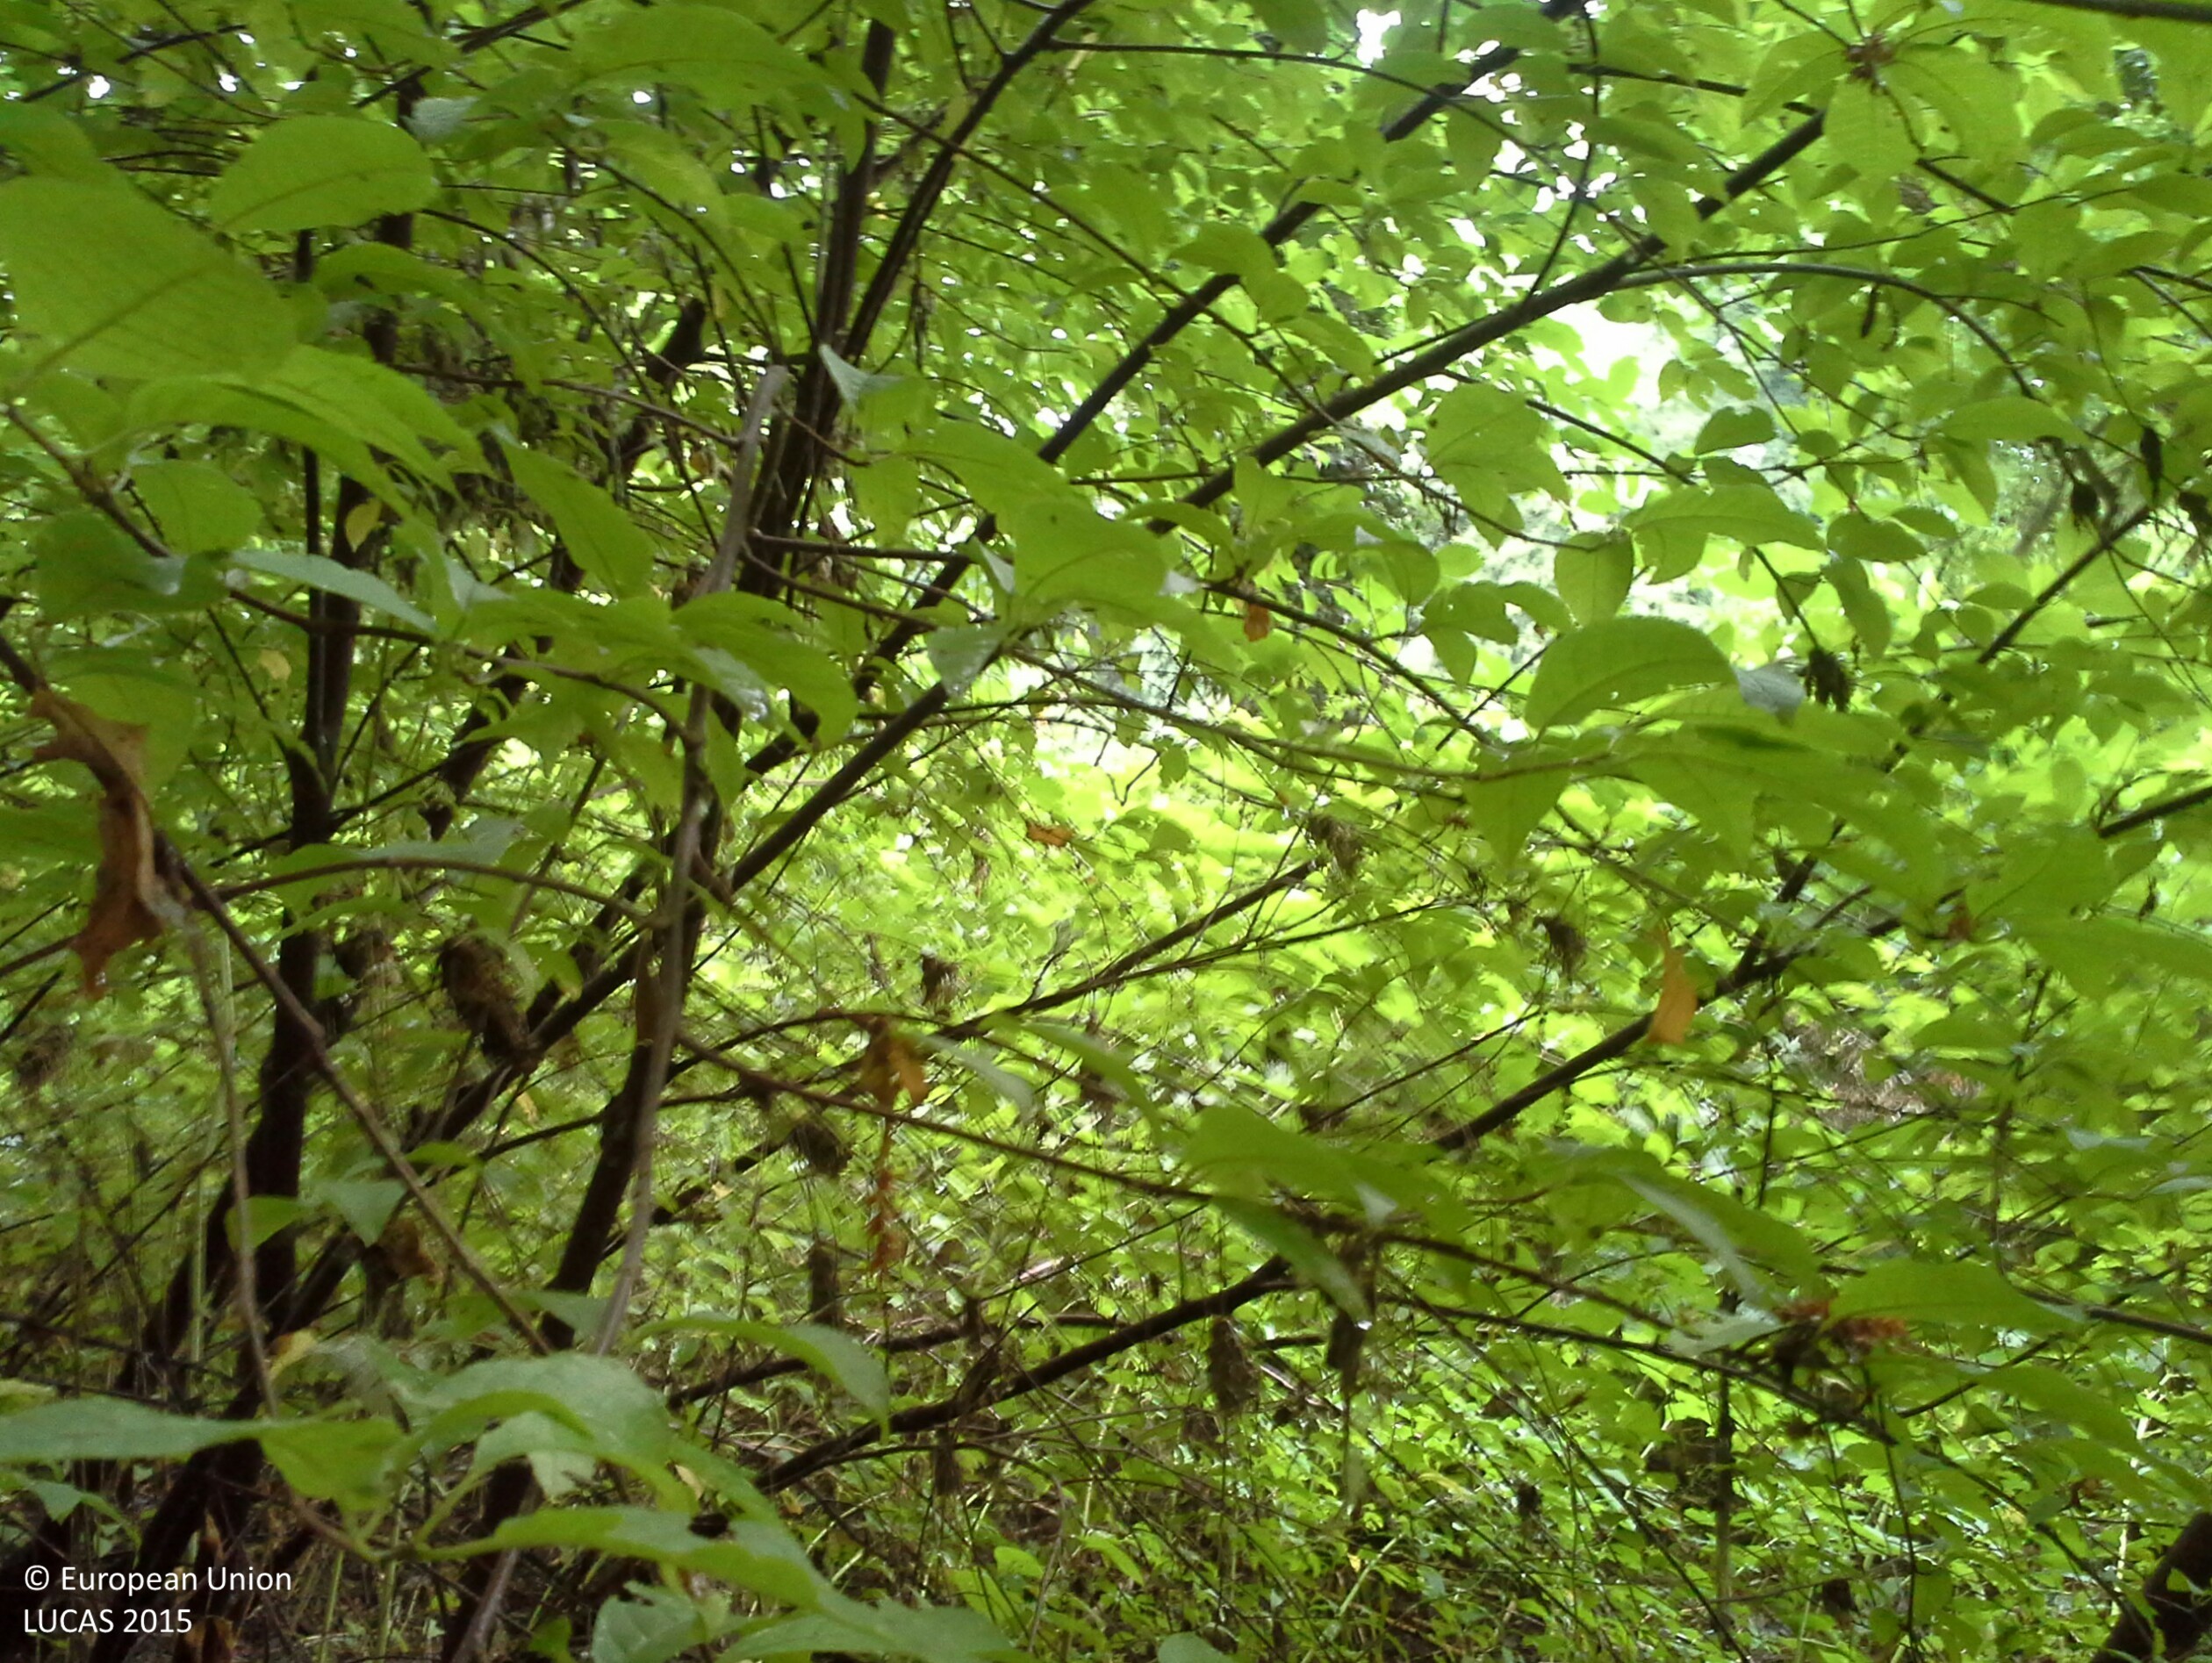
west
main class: Woodland
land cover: Broadleaved woodland
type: floodplain forest
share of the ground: > 75 %
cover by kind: broadleaved forest trees 80 %, shrubs 15 %, herbaceous plants 5 %
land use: Forestry
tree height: > 5 m
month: July
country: AT
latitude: 48.0821
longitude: 14.8198
